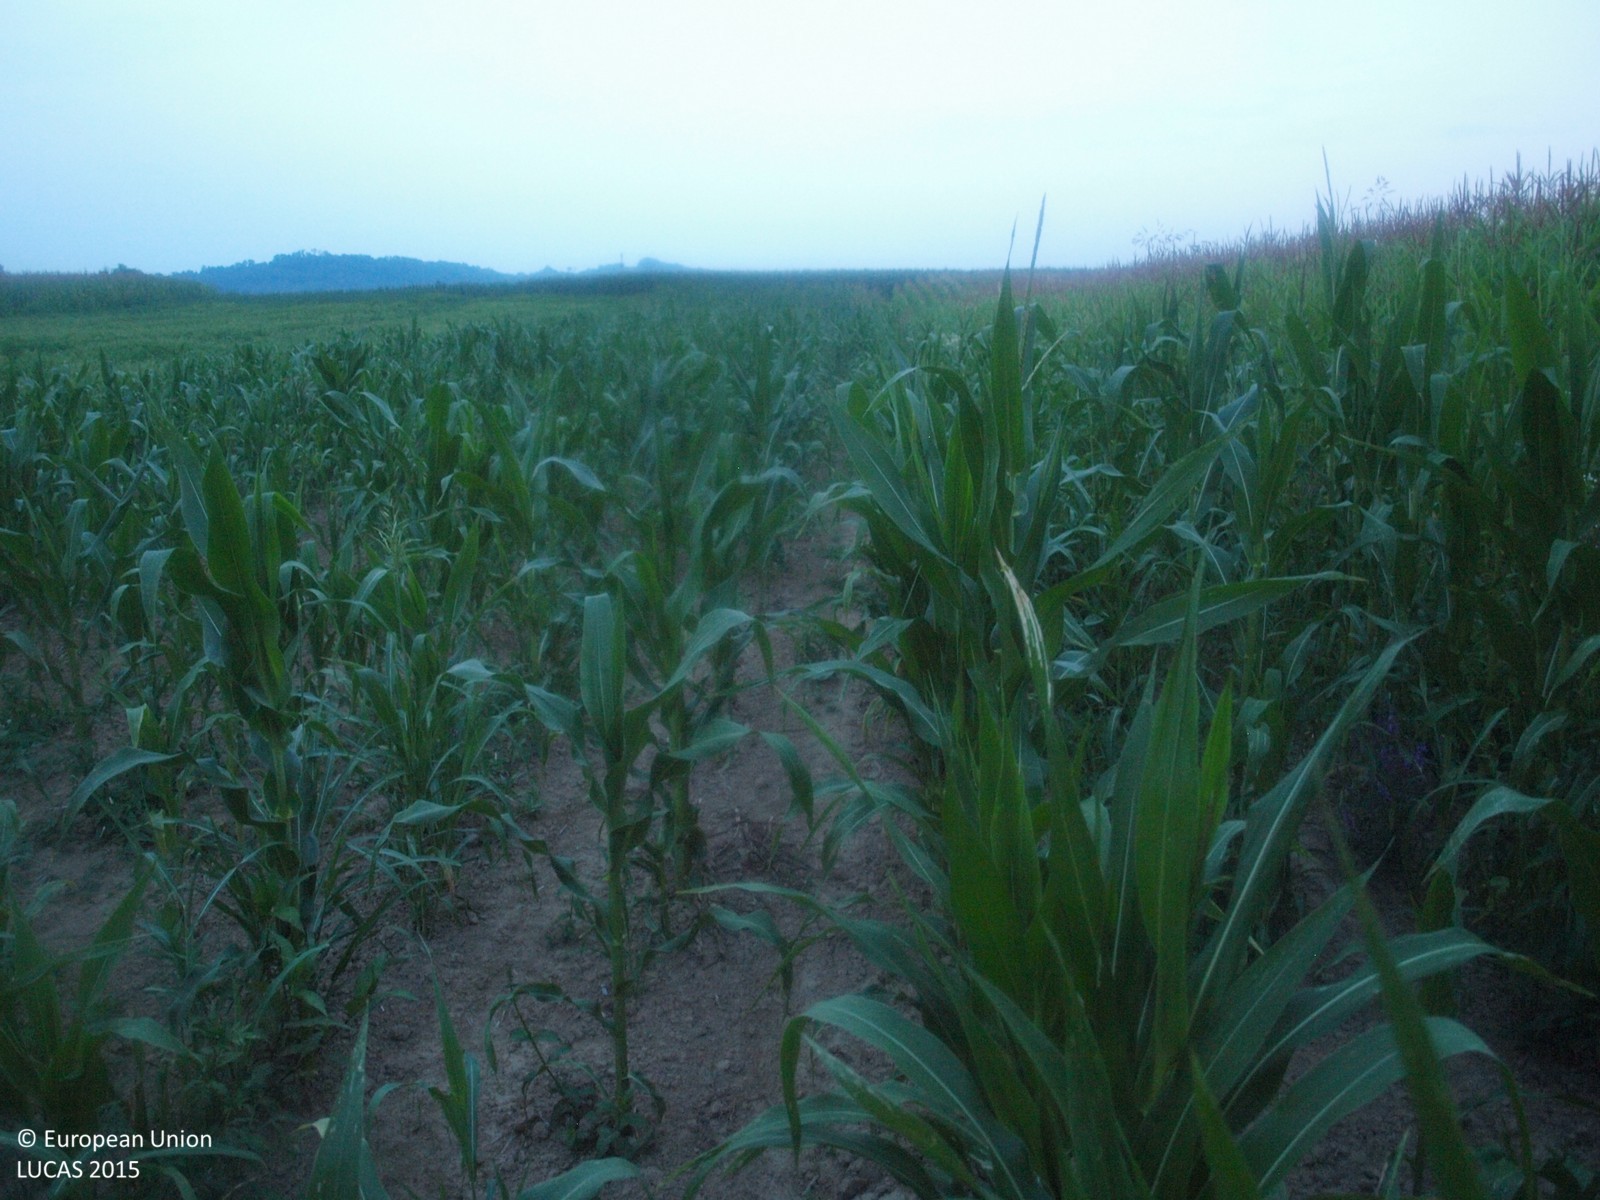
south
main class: Cropland
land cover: Maize
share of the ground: > 75 %
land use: Agriculture (excluding fallow land and kitchen gardens)
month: July
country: HR
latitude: 46.2407
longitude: 16.5498
